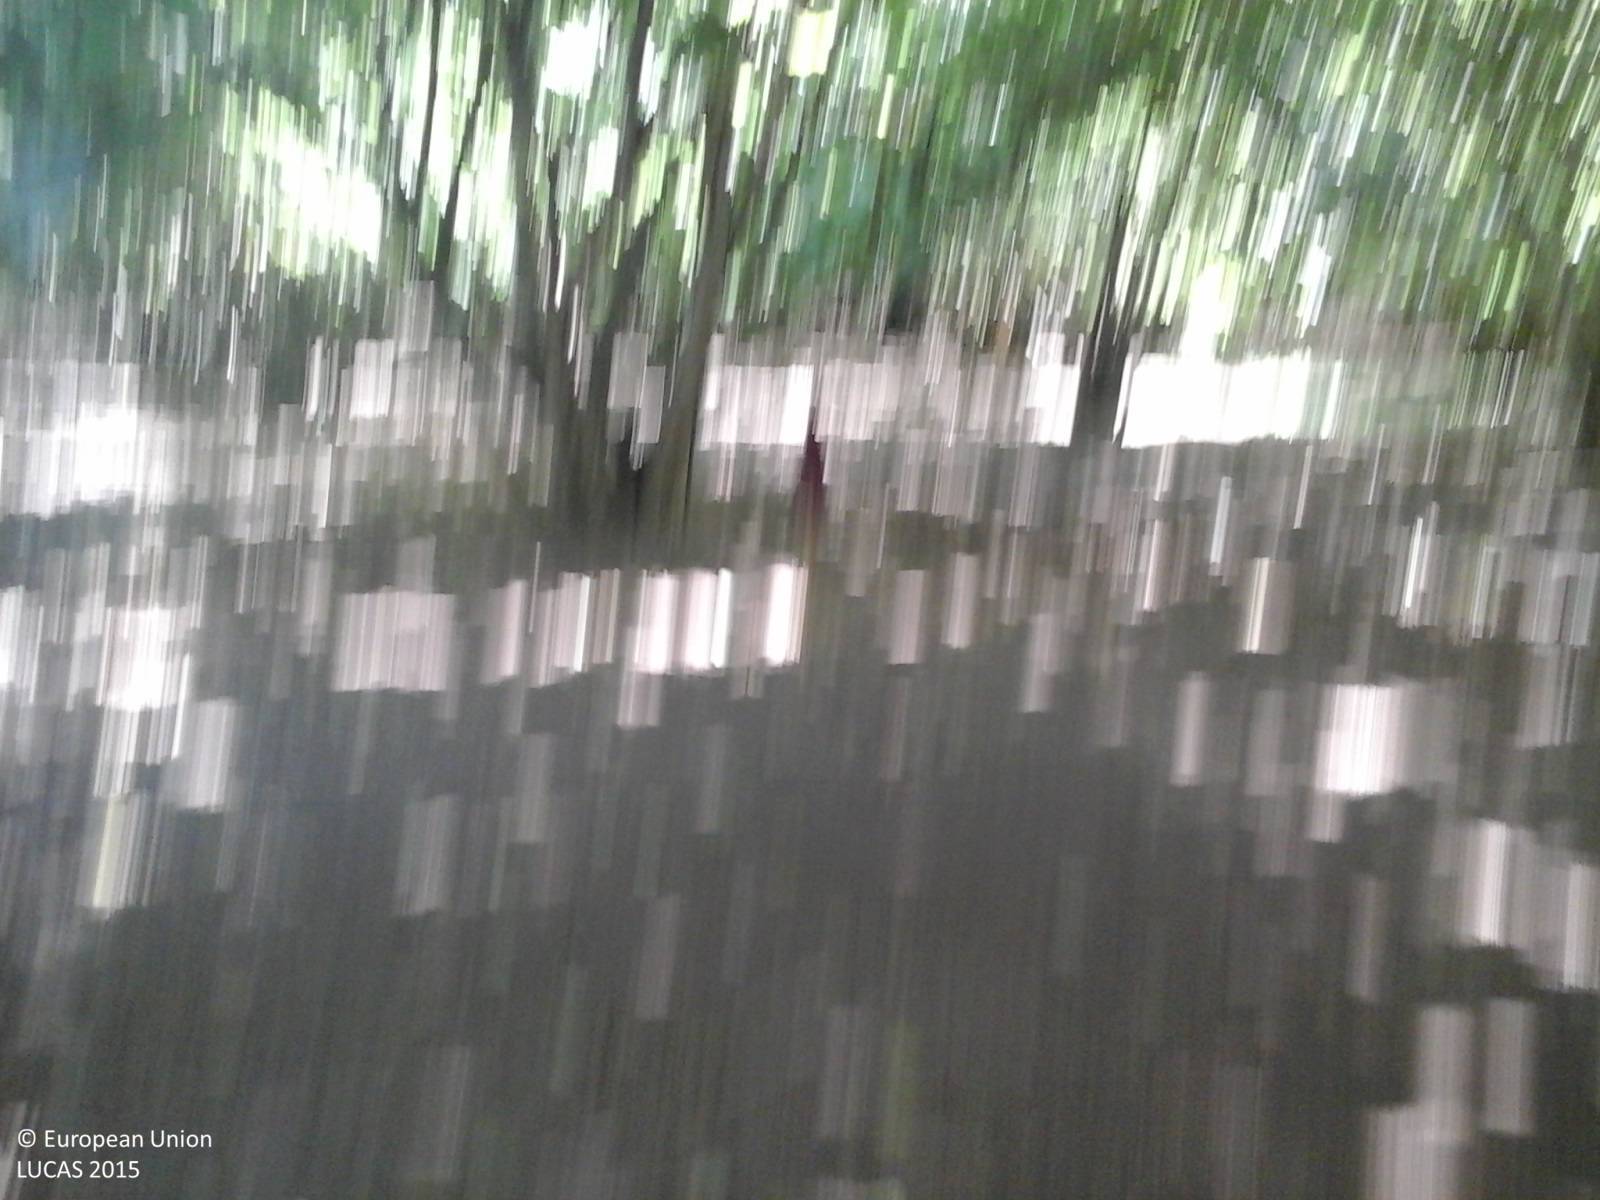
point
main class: Cropland
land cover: Nuts trees
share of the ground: > 75 %
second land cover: Other bare soil
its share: > 75 %
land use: Agriculture (excluding fallow land and kitchen gardens)
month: September
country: IT
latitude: 42.3752
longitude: 12.2875
